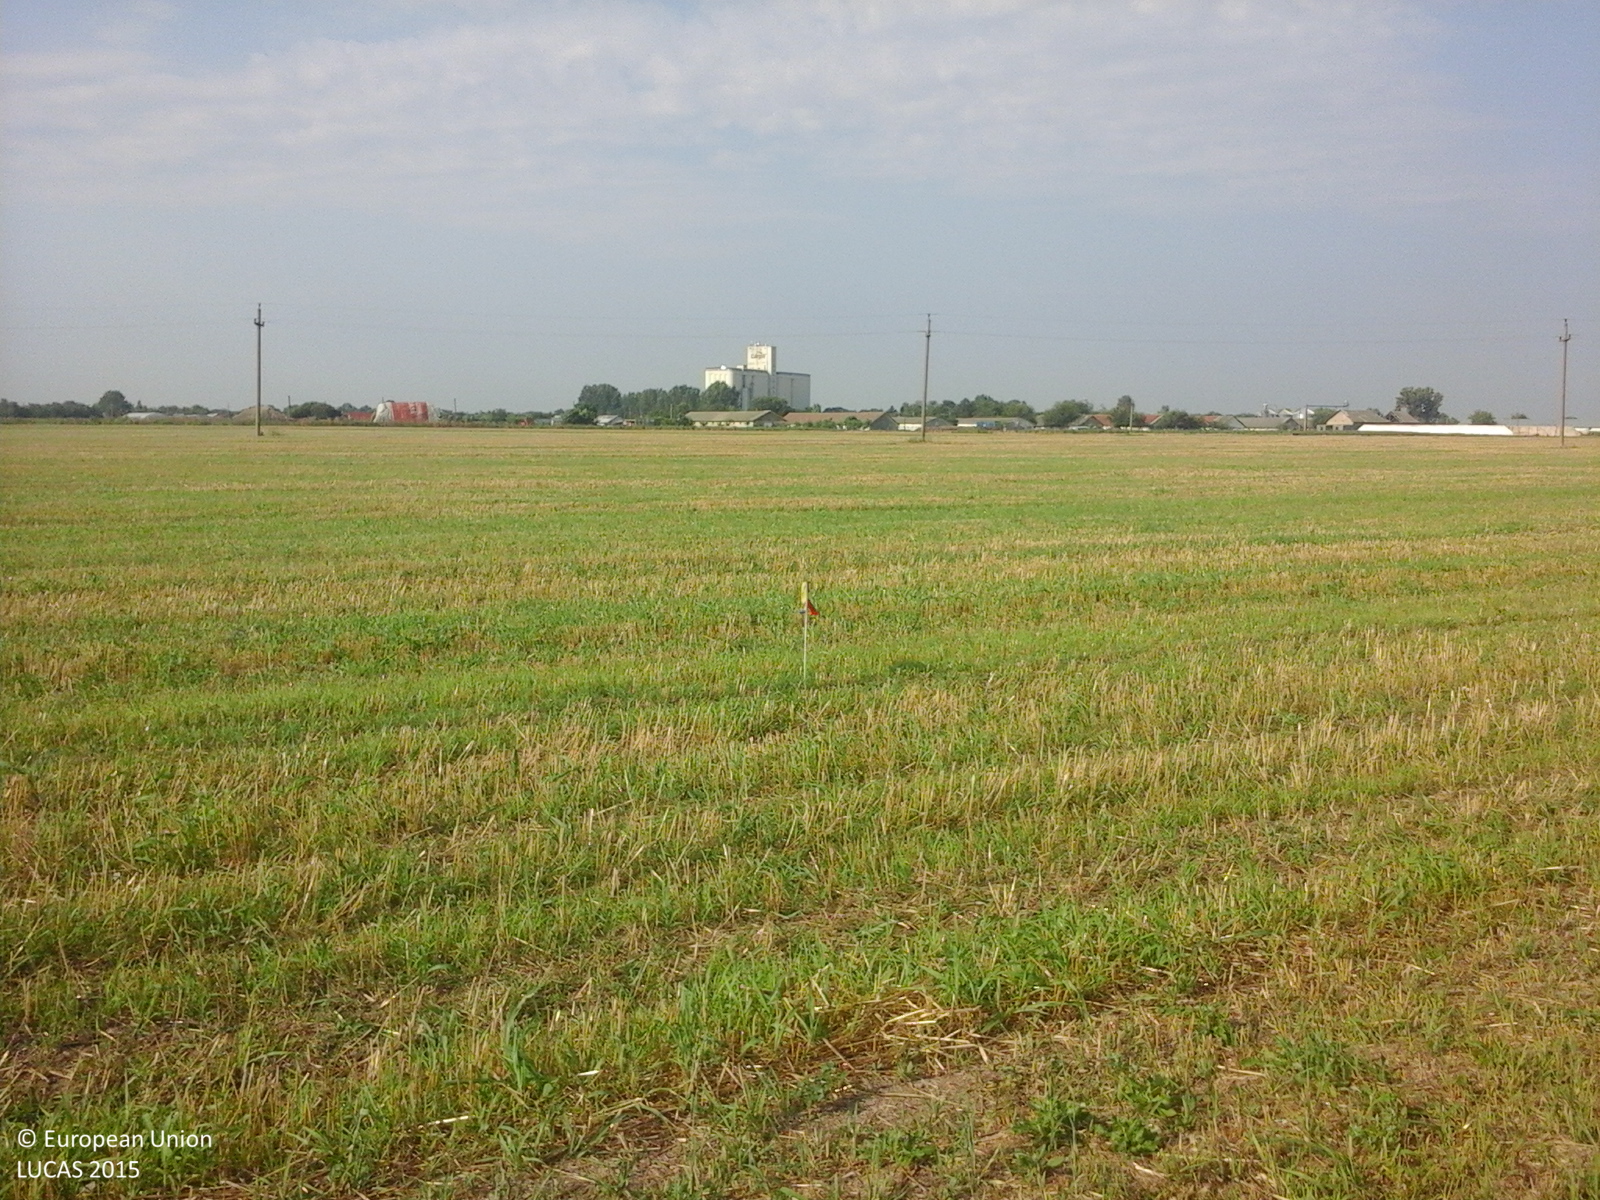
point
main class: Cropland
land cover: Barley
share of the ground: < 10 %
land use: Agriculture (excluding fallow land and kitchen gardens)
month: July
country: RO
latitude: 44.6180
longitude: 27.4977
